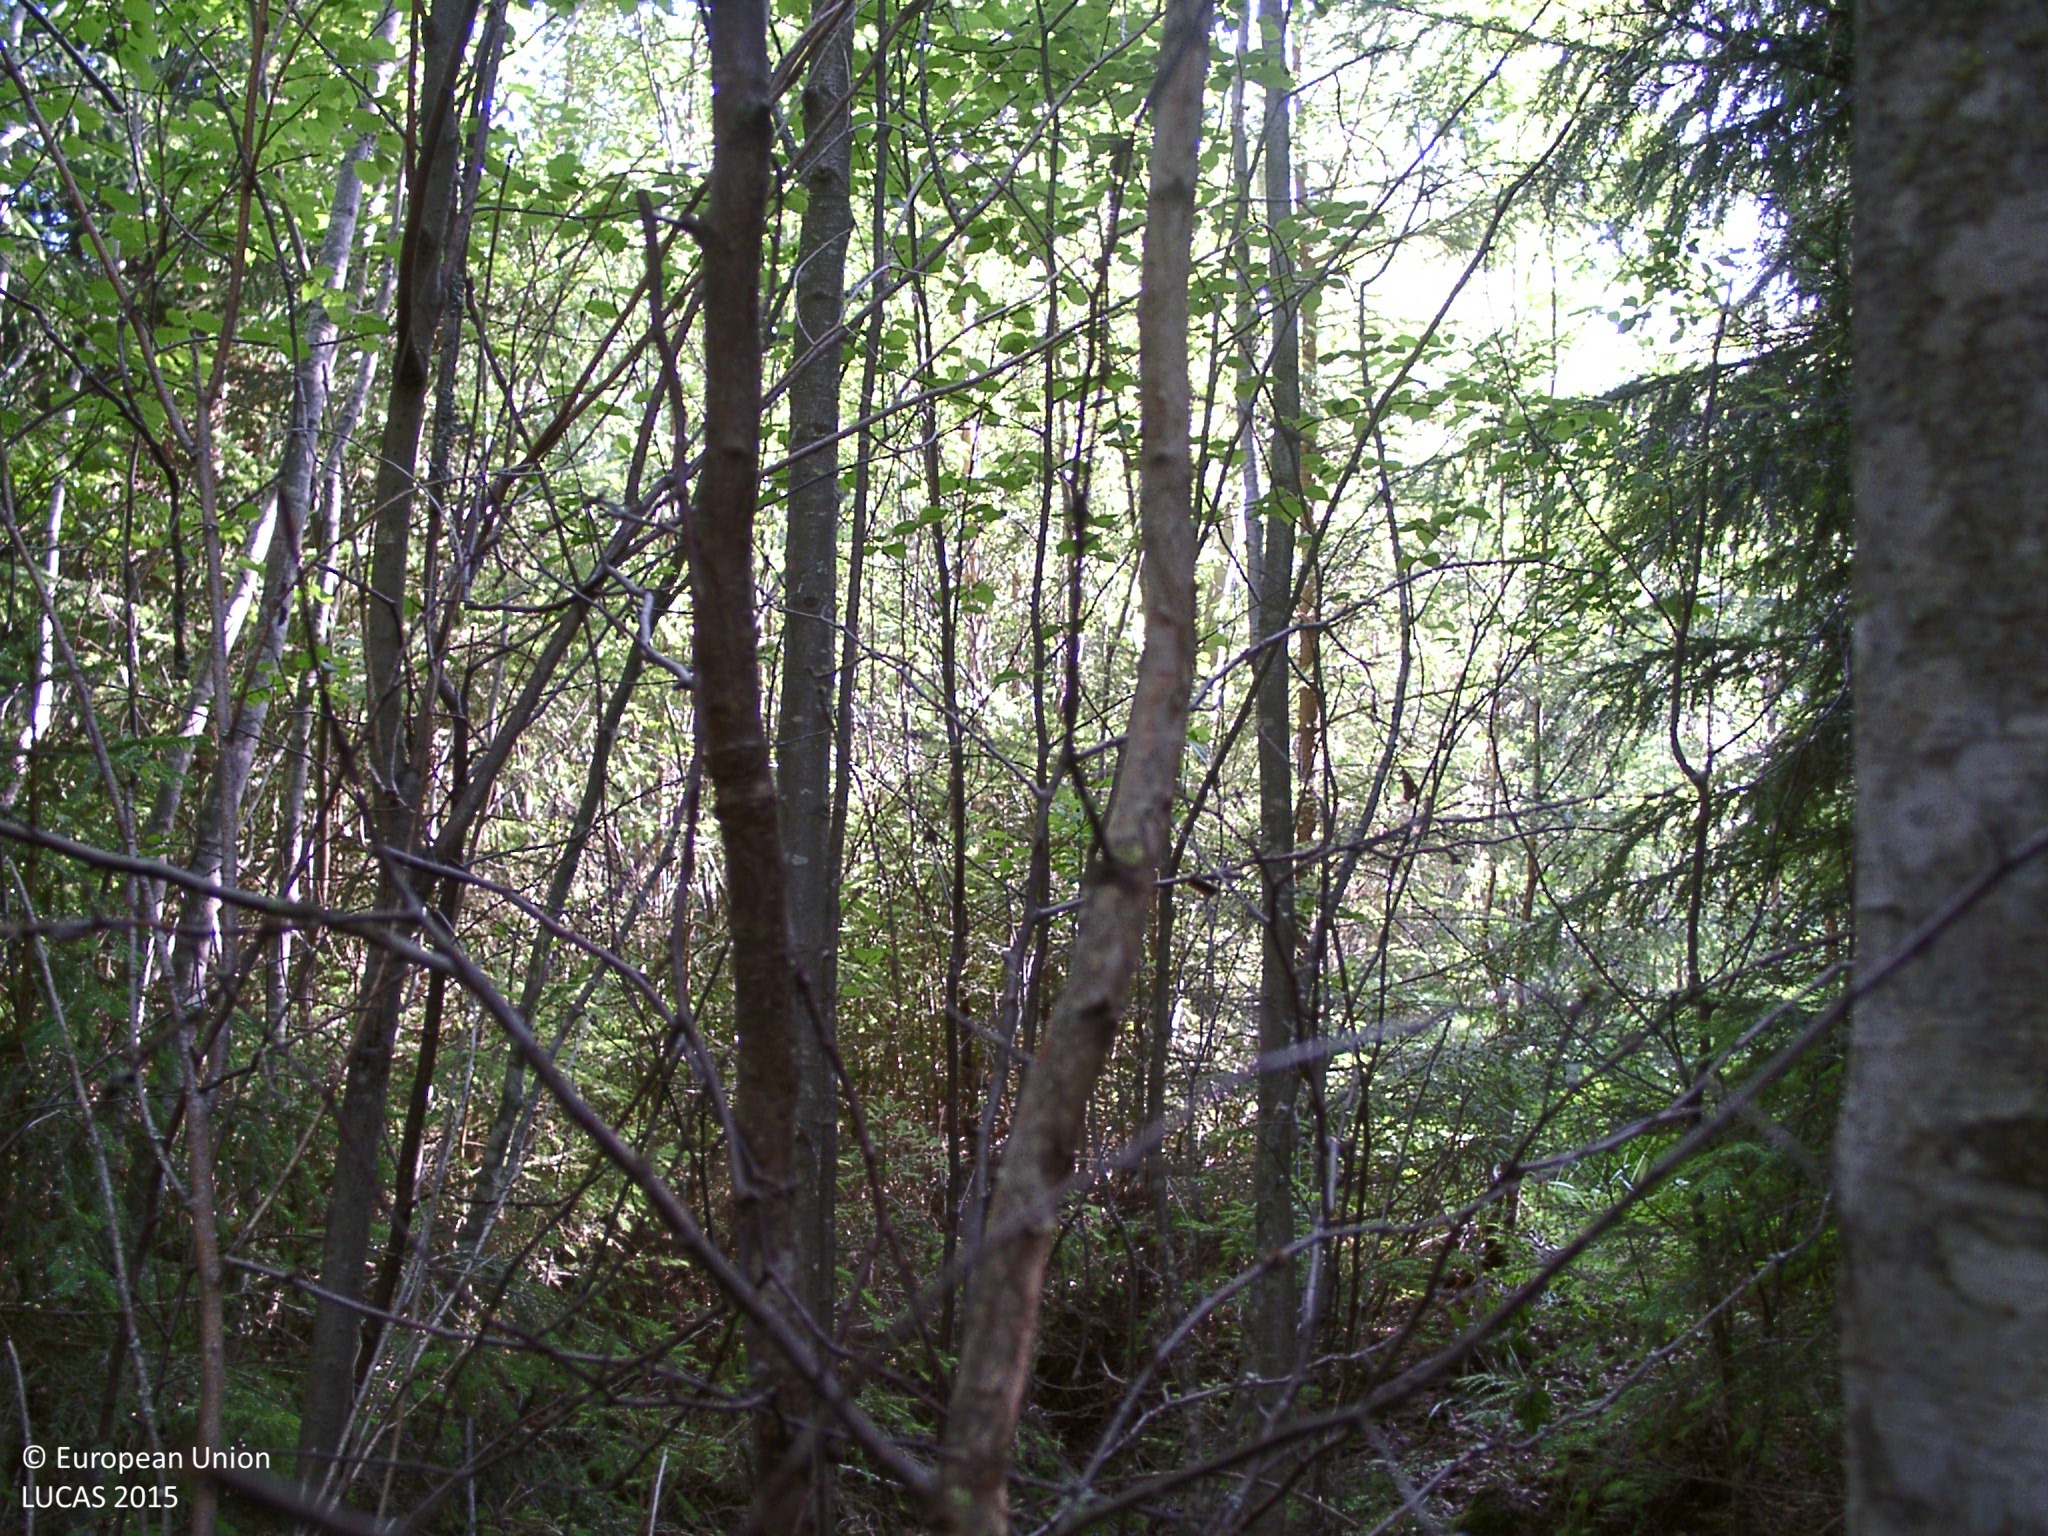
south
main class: Woodland
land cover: Spruce dominated mixed woodland
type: boreal forest
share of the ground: > 75 %
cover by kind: broadleaved forest trees 60 %, coniferous forest trees 25 %, herbaceous plants 10 %, unconsolidated bare surface 5 %
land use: Forestry
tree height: > 5 m
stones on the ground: < 10 %
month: July
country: FI
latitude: 61.5860
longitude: 25.2803
